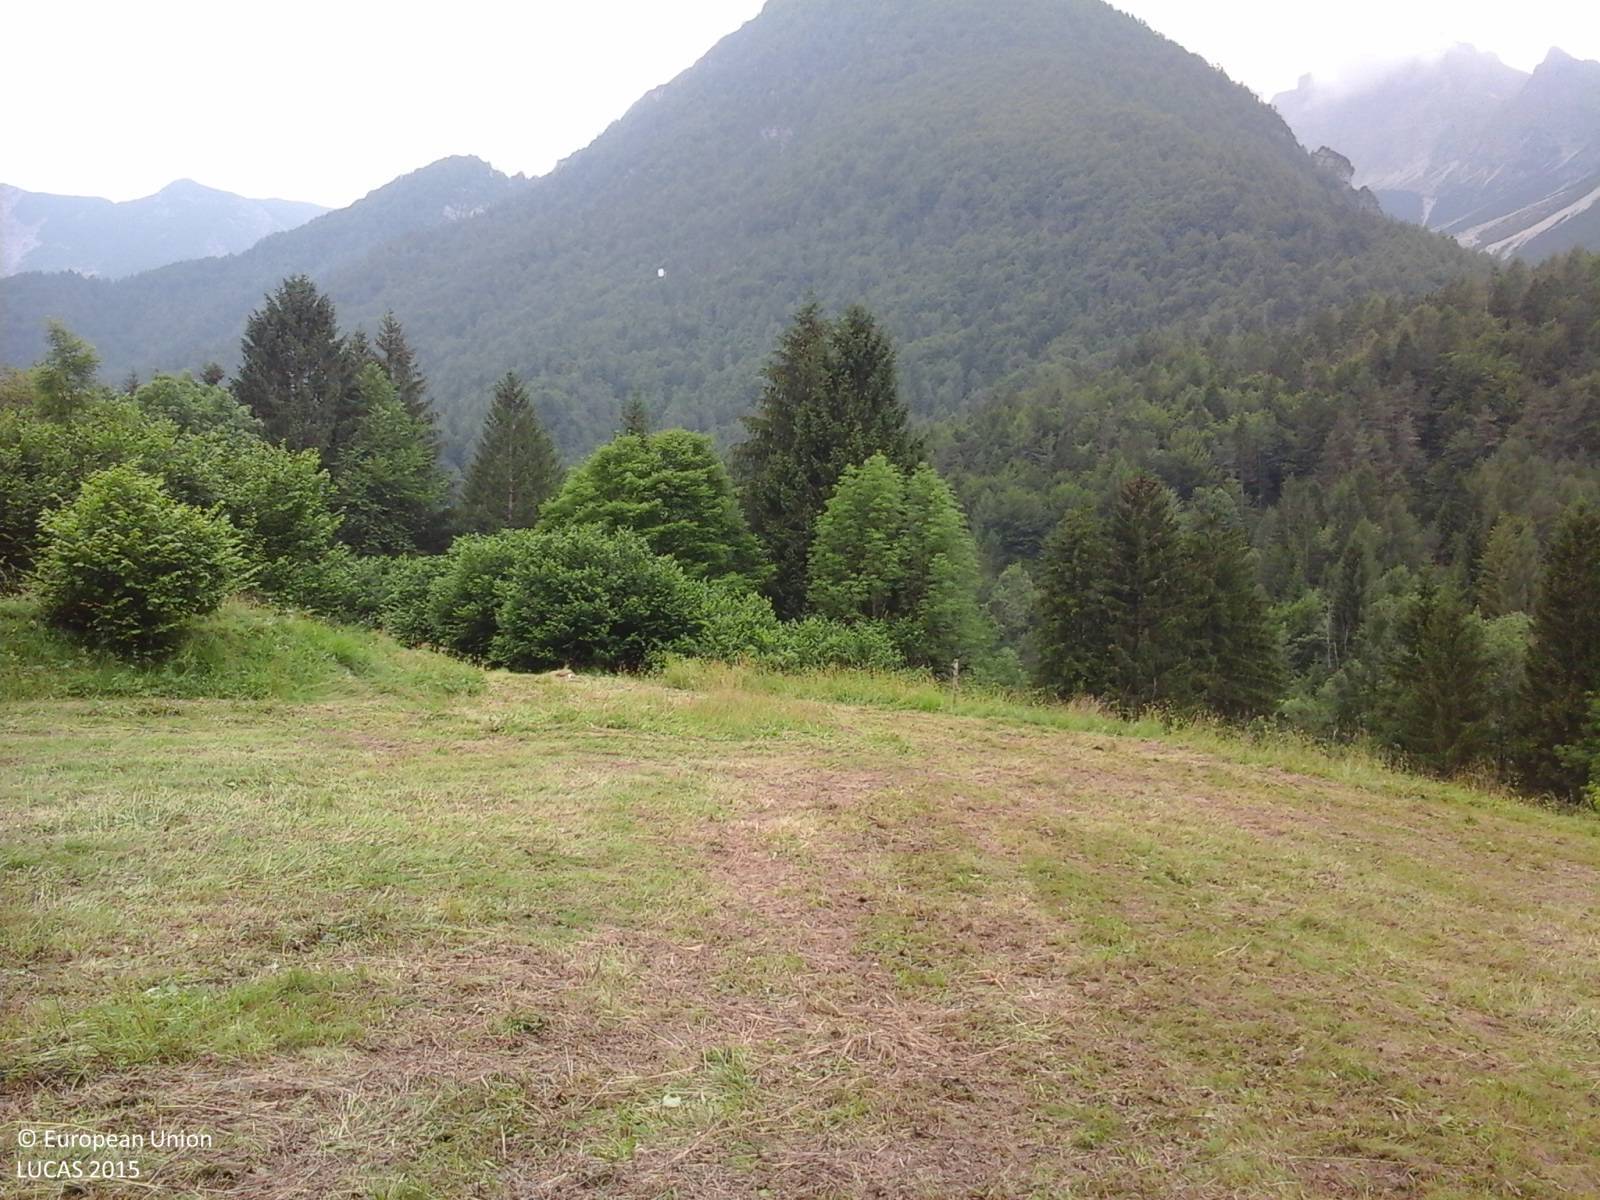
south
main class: Grassland
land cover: Grassland without tree/shrub cover
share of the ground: > 75 %
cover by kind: herbaceous plants 100 %
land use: Agriculture (excluding fallow land and kitchen gardens)
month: July
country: IT
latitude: 46.4101
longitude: 12.5859
